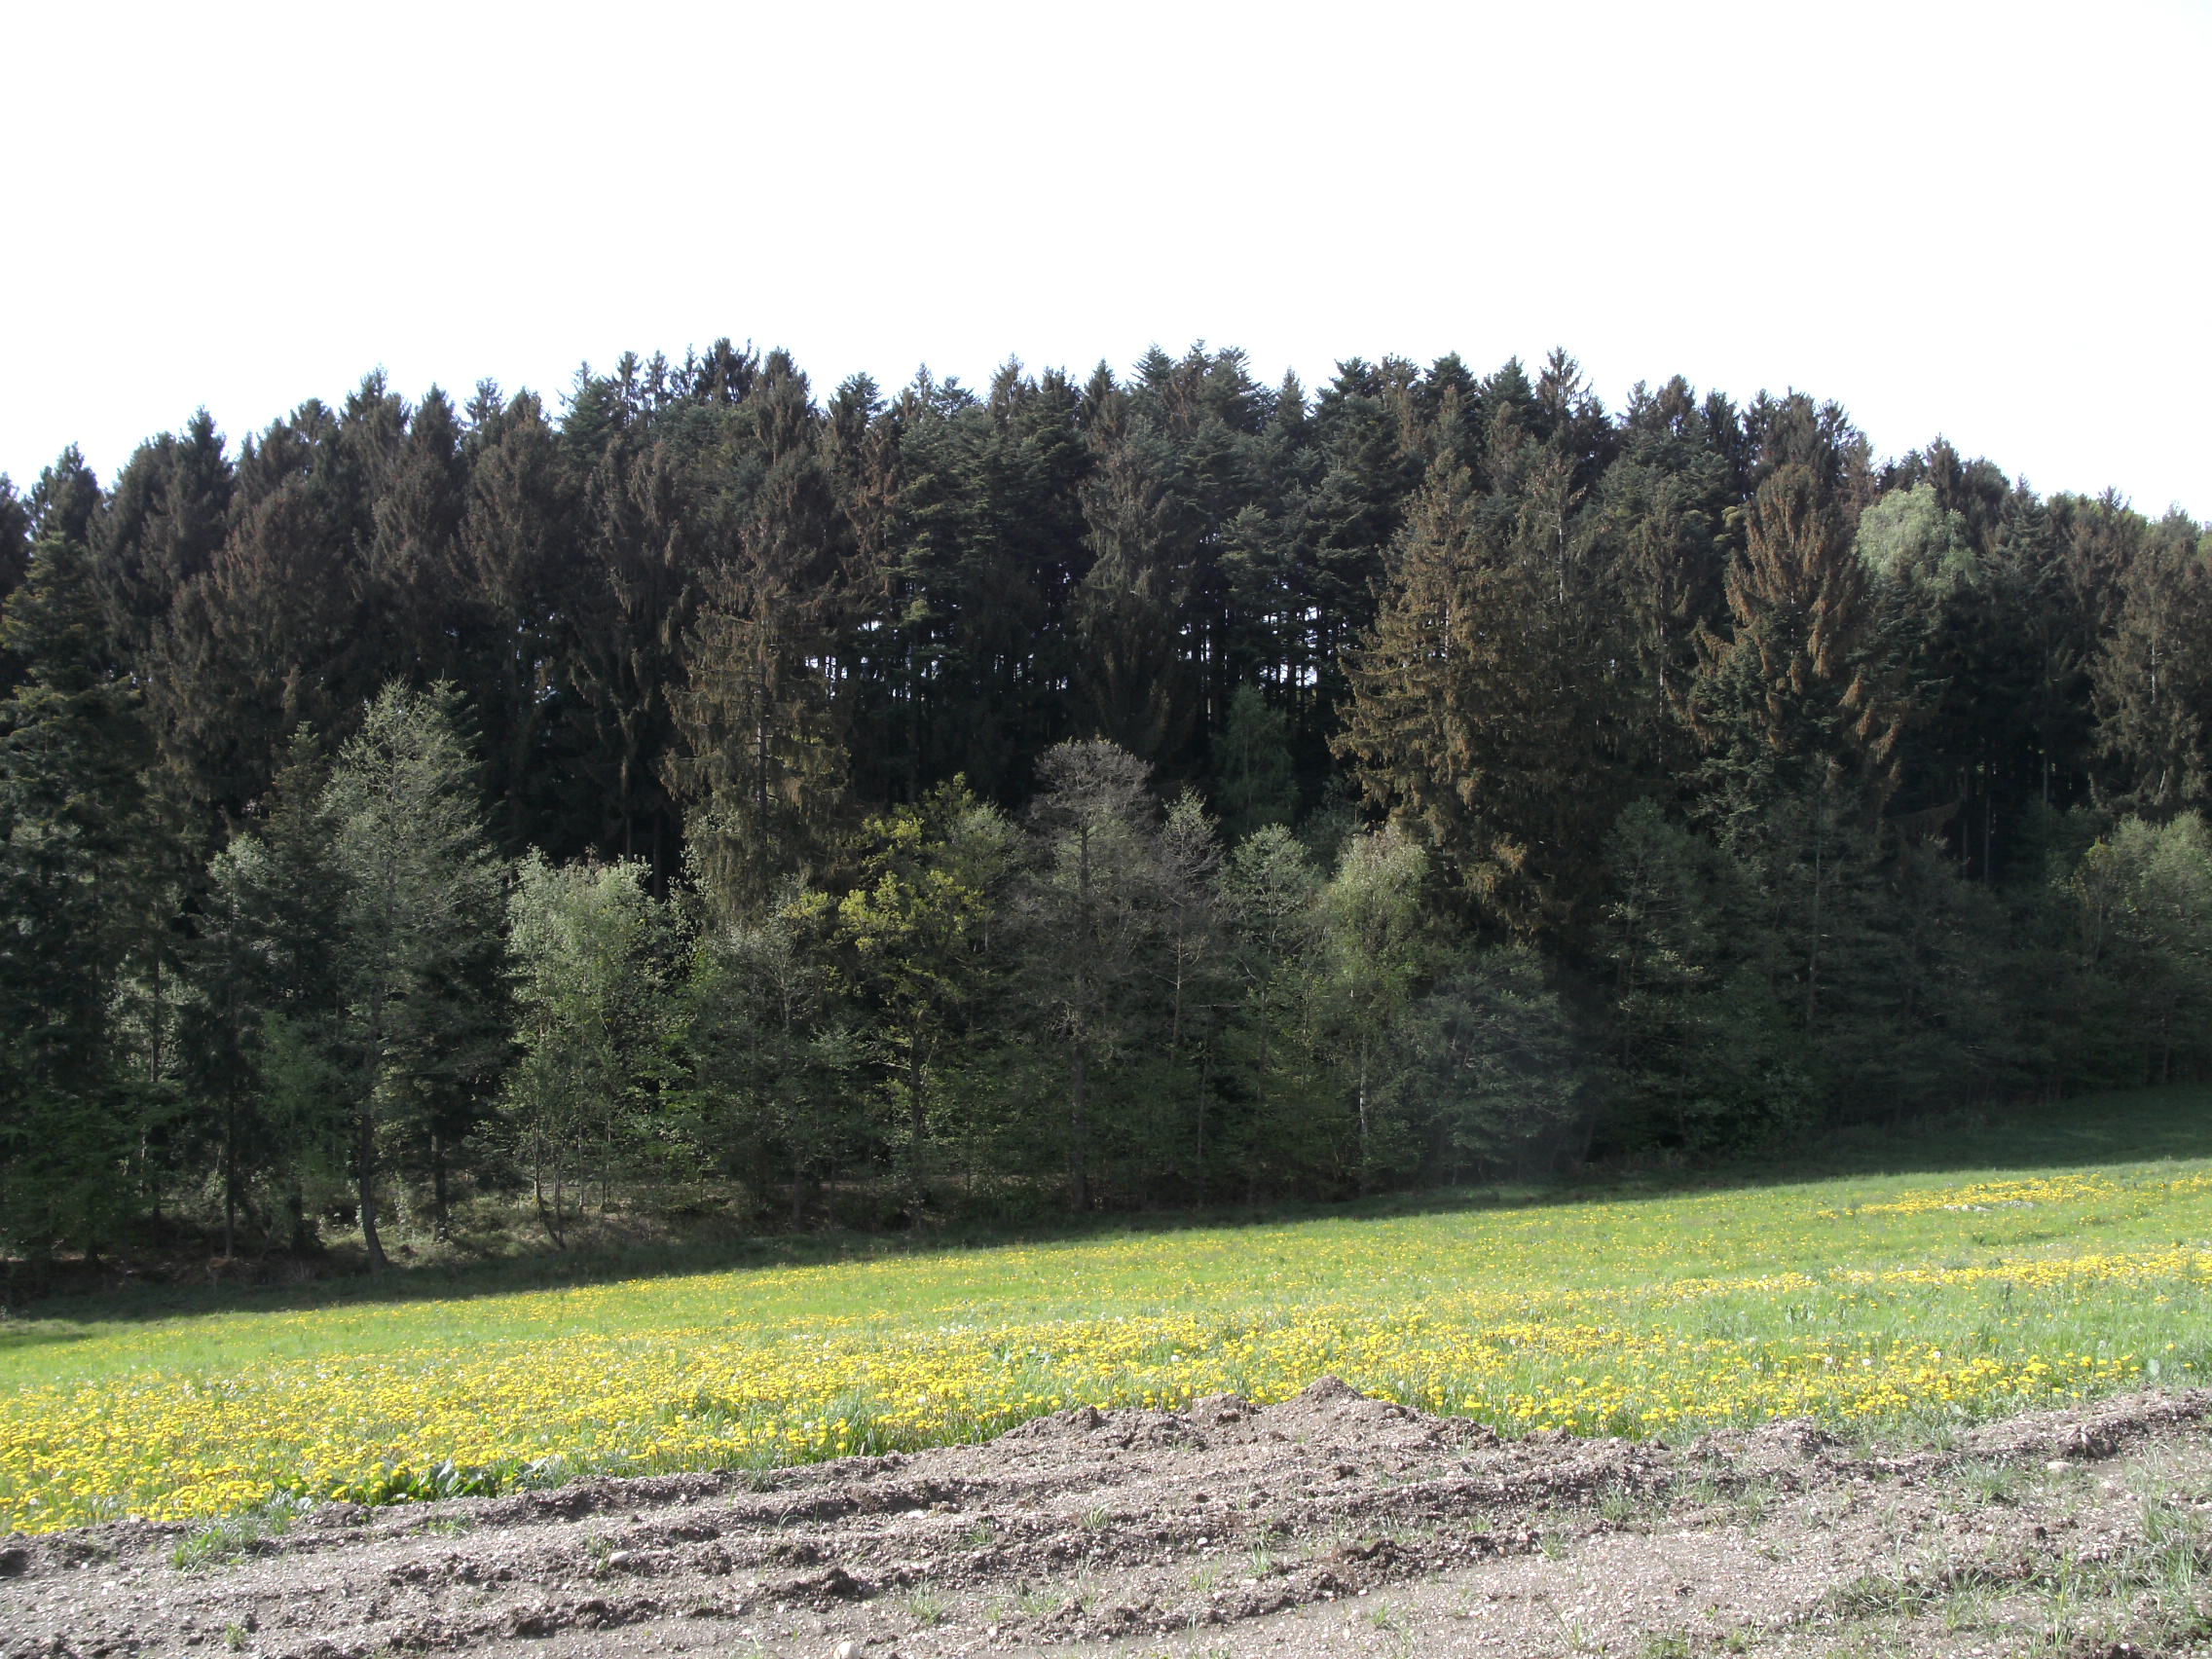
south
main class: Grassland
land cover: Spontaneously vegetated surfaces
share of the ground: 10 - 25 %
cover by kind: unconsolidated bare surface 90 %, herbaceous plants 10 %
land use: Agriculture (excluding fallow land and kitchen gardens)
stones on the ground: 10 - 25 %
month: May
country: AT
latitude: 48.1172
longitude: 13.3976
